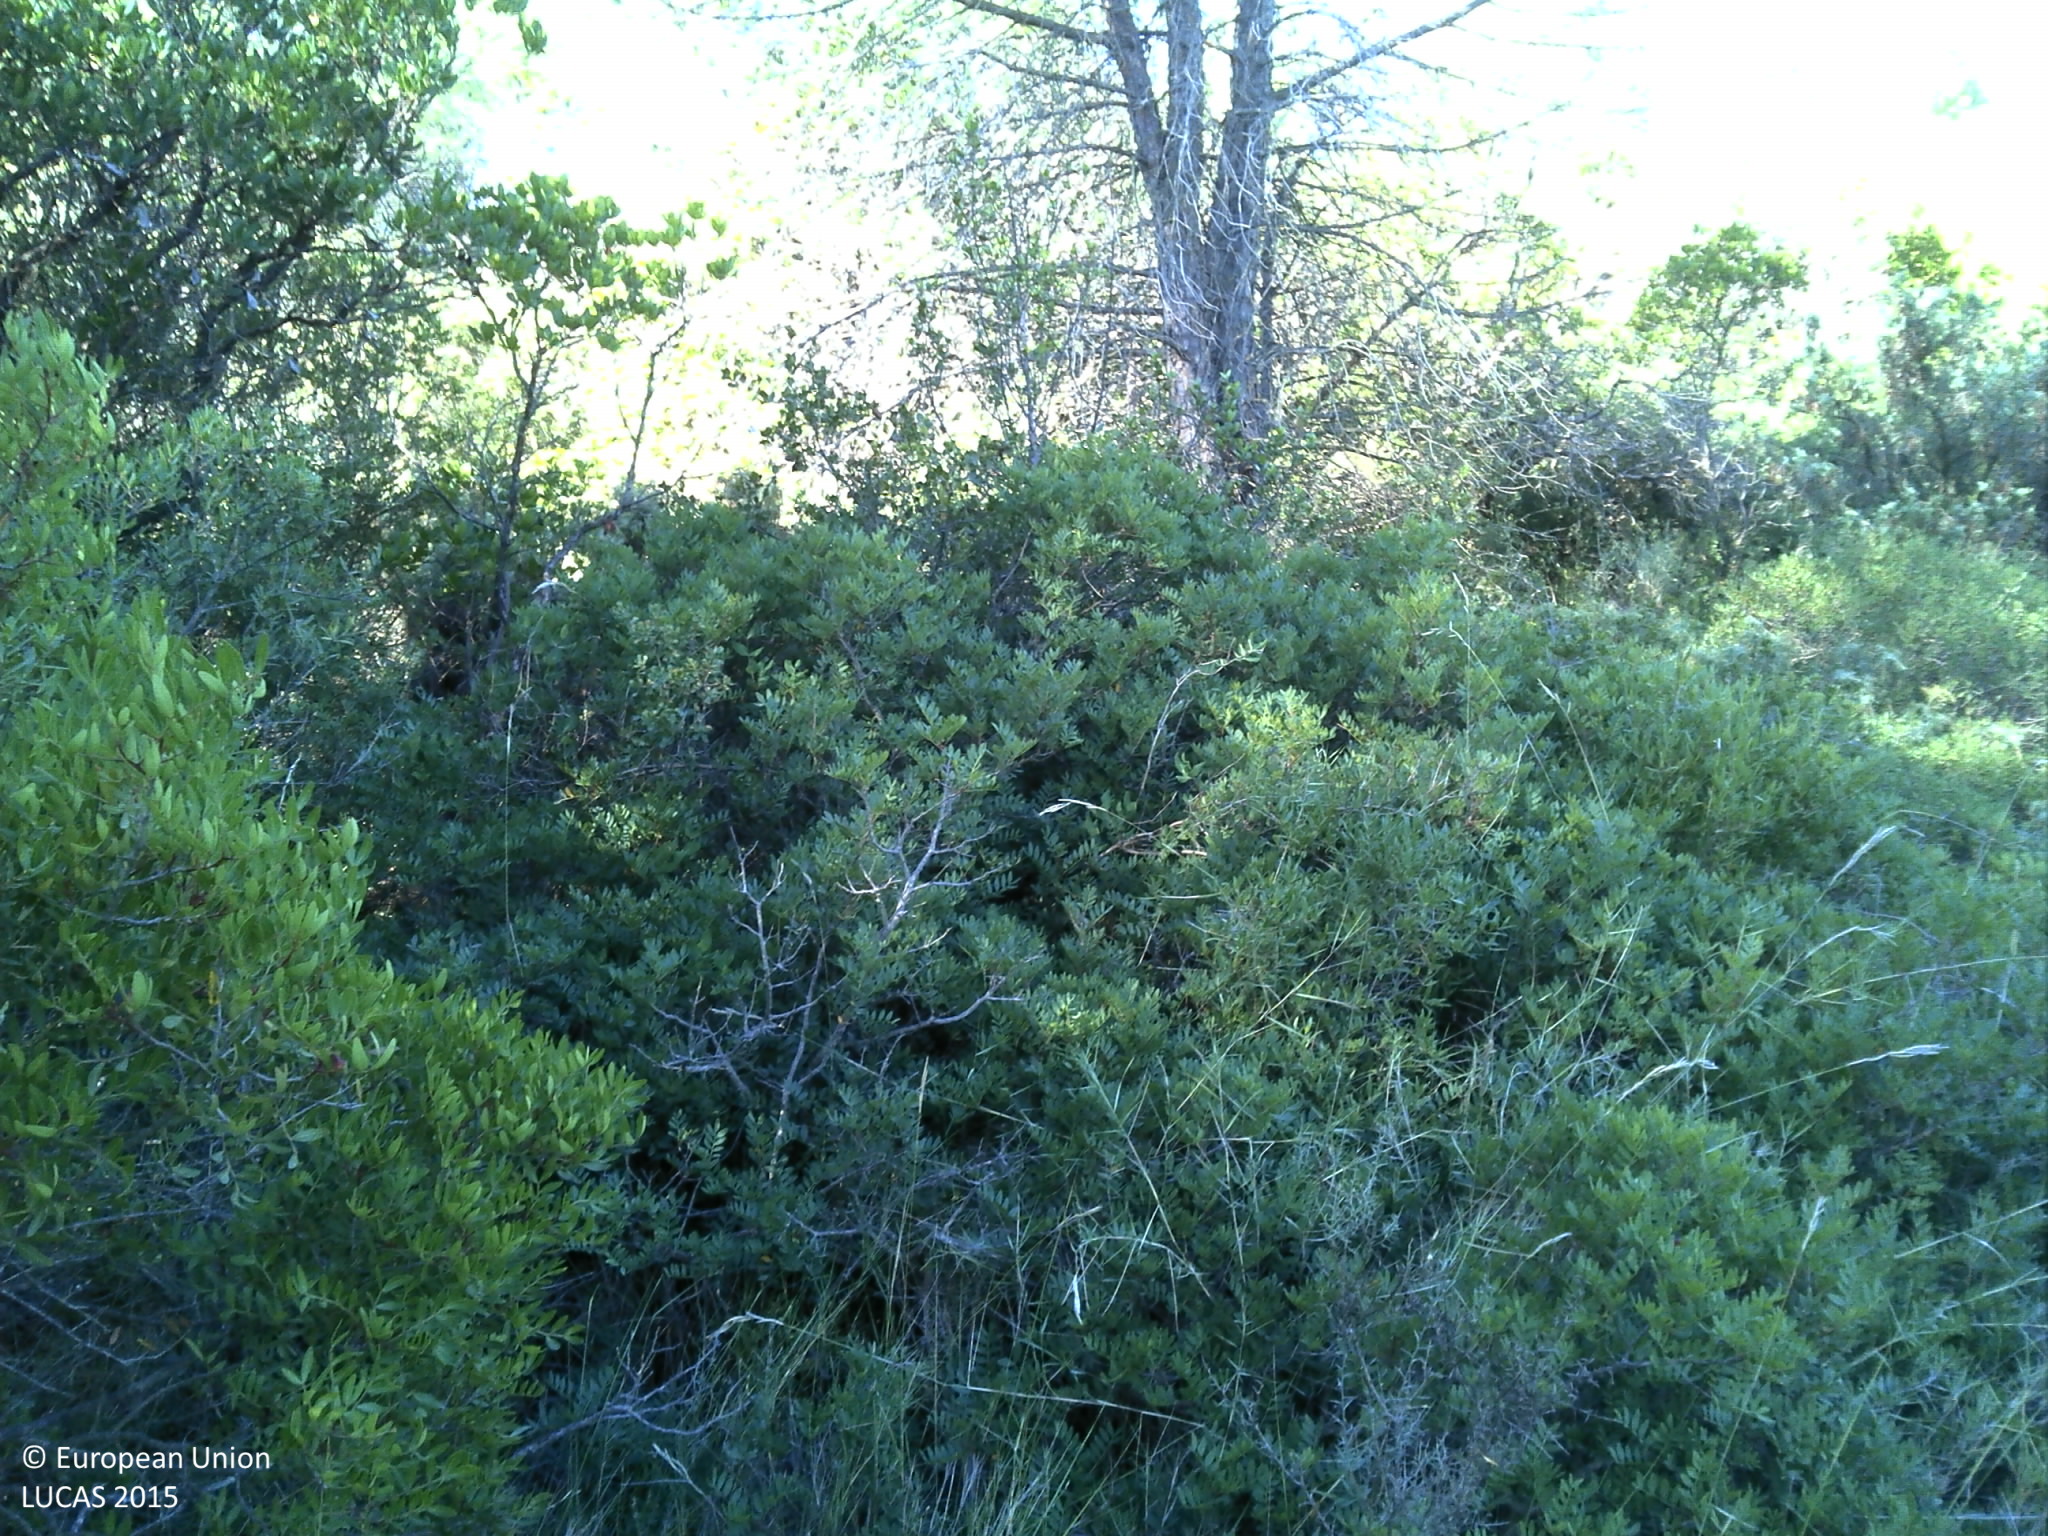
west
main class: Woodland
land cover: Pine dominated mixed woodland
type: coniferous forest of the mediterranean region
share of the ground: > 75 %
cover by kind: coniferous forest trees 45 %, broadleaved forest trees 30 %, shrubs 15 %, herbaceous plants 10 %
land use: Semi-natural and natural areas not in use
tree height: > 5 m
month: October
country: FR
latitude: 43.4903
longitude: 3.1458
